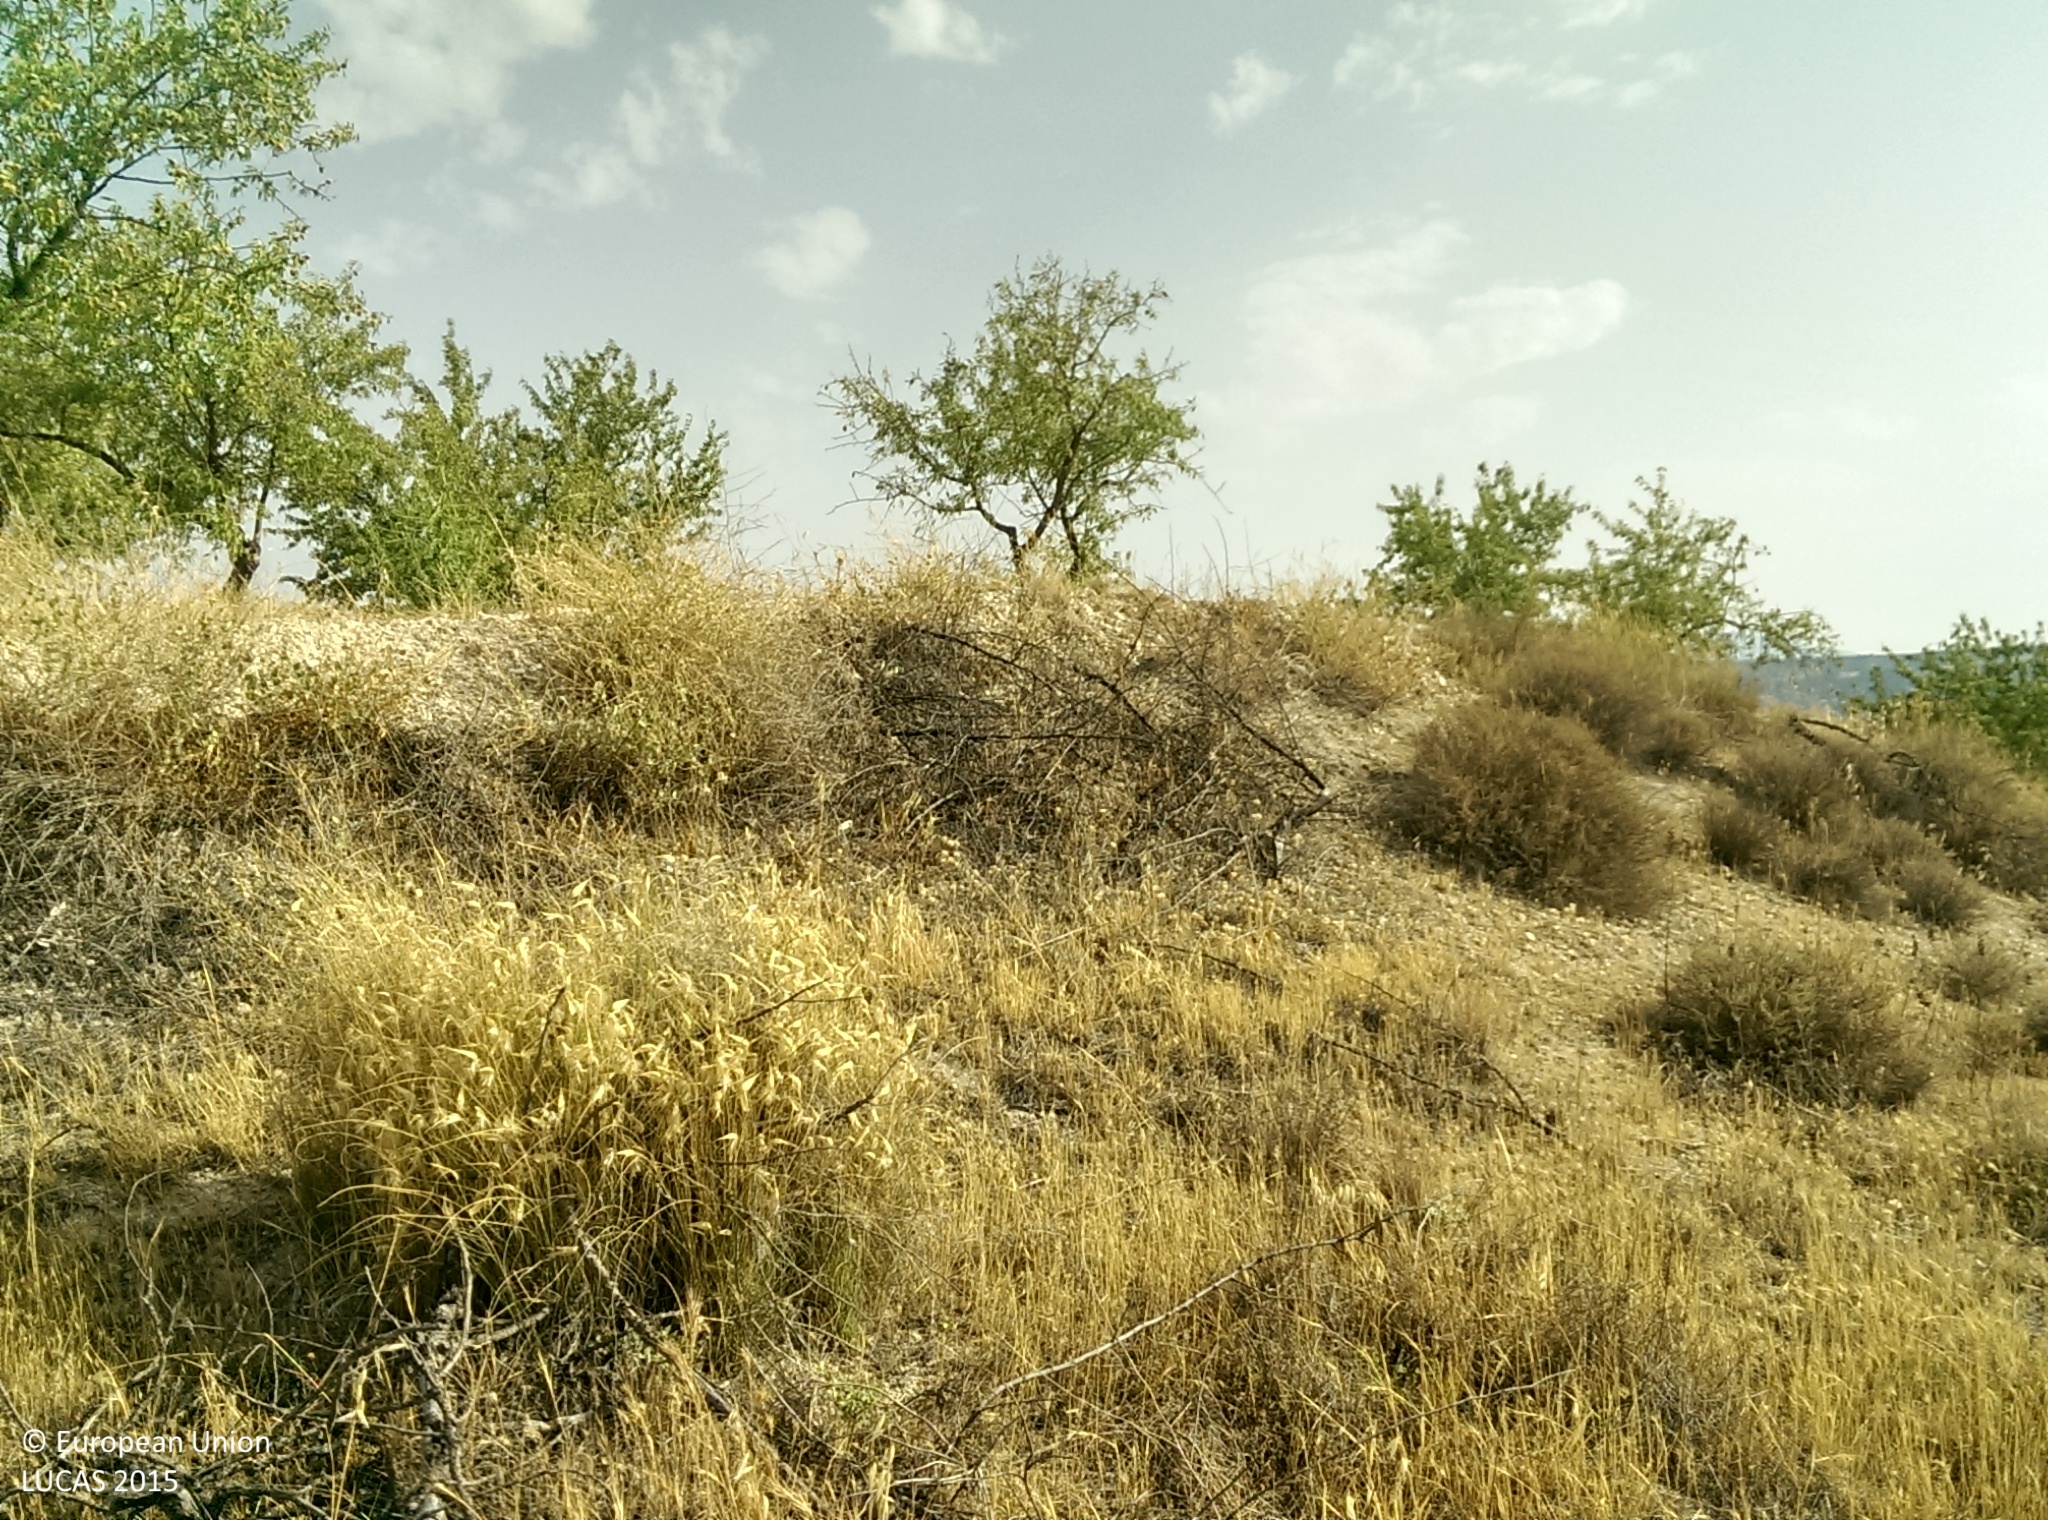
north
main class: Cropland
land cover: Nuts trees
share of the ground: 25 - 50 %
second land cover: Other bare soil
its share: > 75 %
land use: Agriculture (excluding fallow land and kitchen gardens)
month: July
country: ES
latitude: 37.5998
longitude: -2.8906
